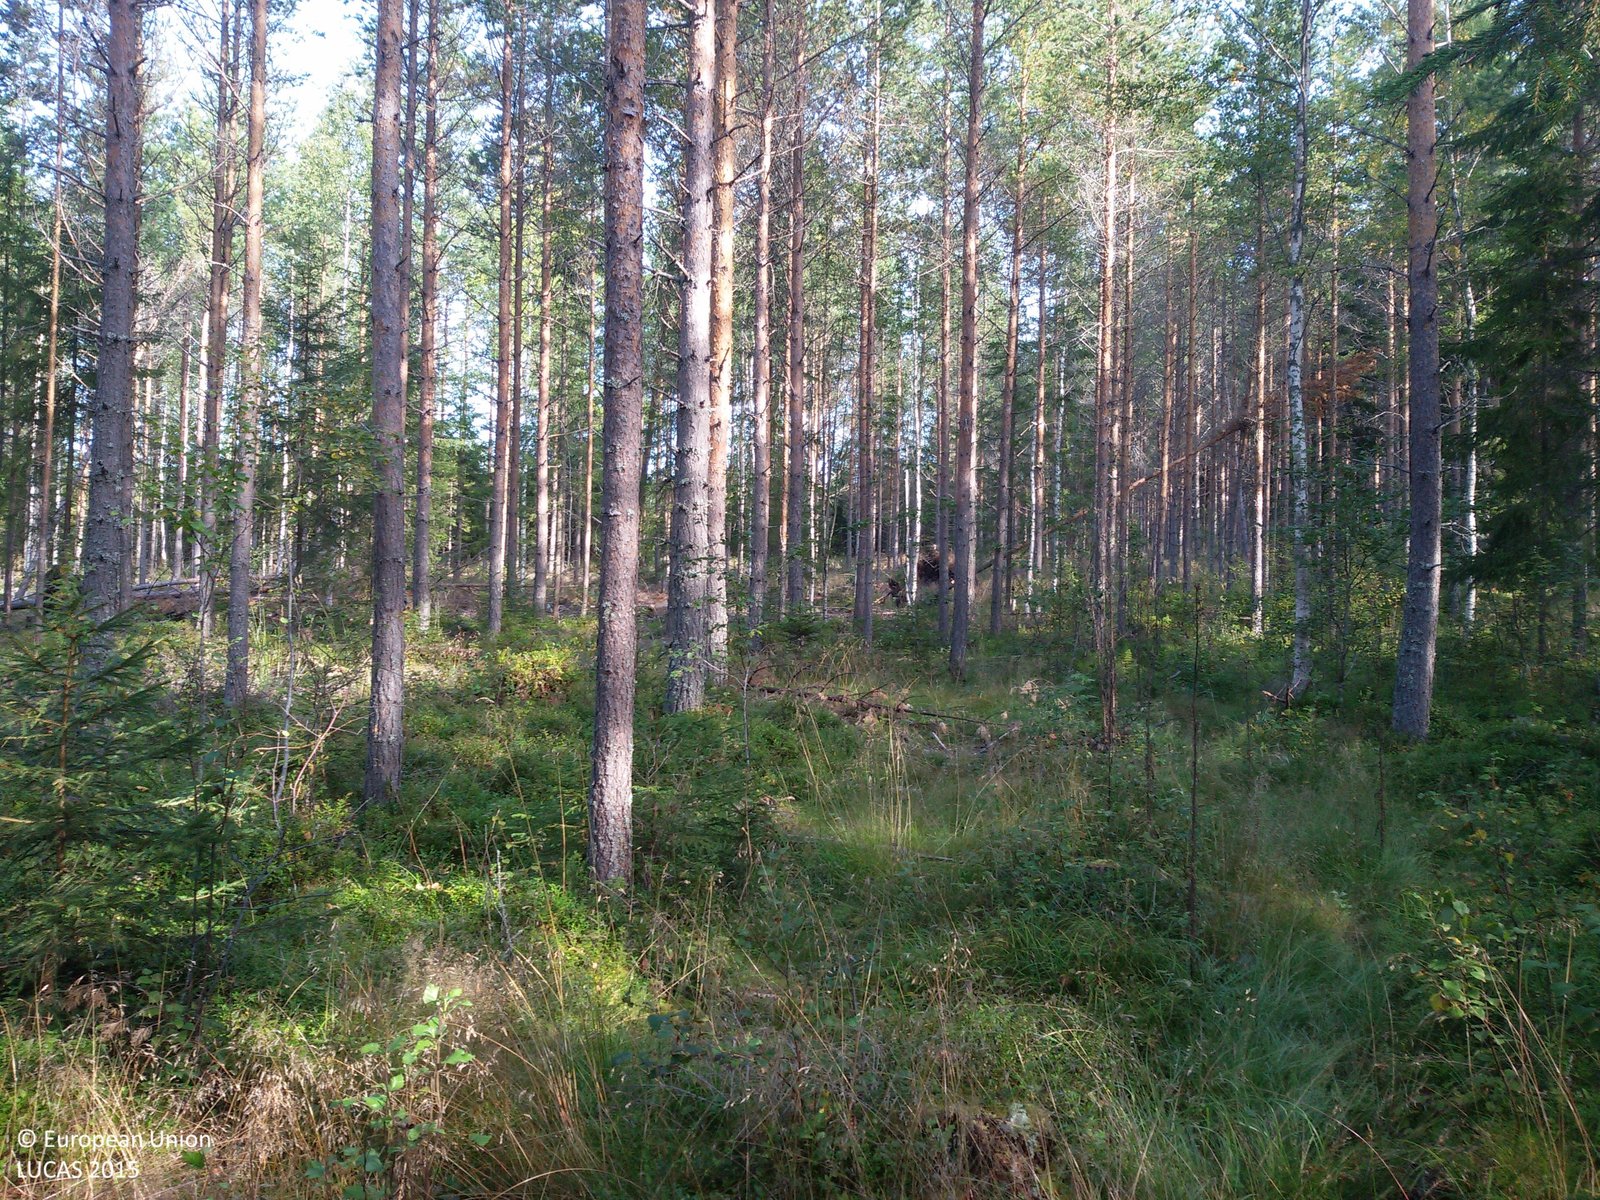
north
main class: Woodland
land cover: Pine dominated coniferous woodland
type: boreal forest
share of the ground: 50 - 75 %
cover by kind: coniferous forest trees 70 %, herbaceous plants 25 %, lichens and mosses 5 %
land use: Forestry
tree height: > 5 m
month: September
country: SE
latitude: 60.9573
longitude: 15.0275
